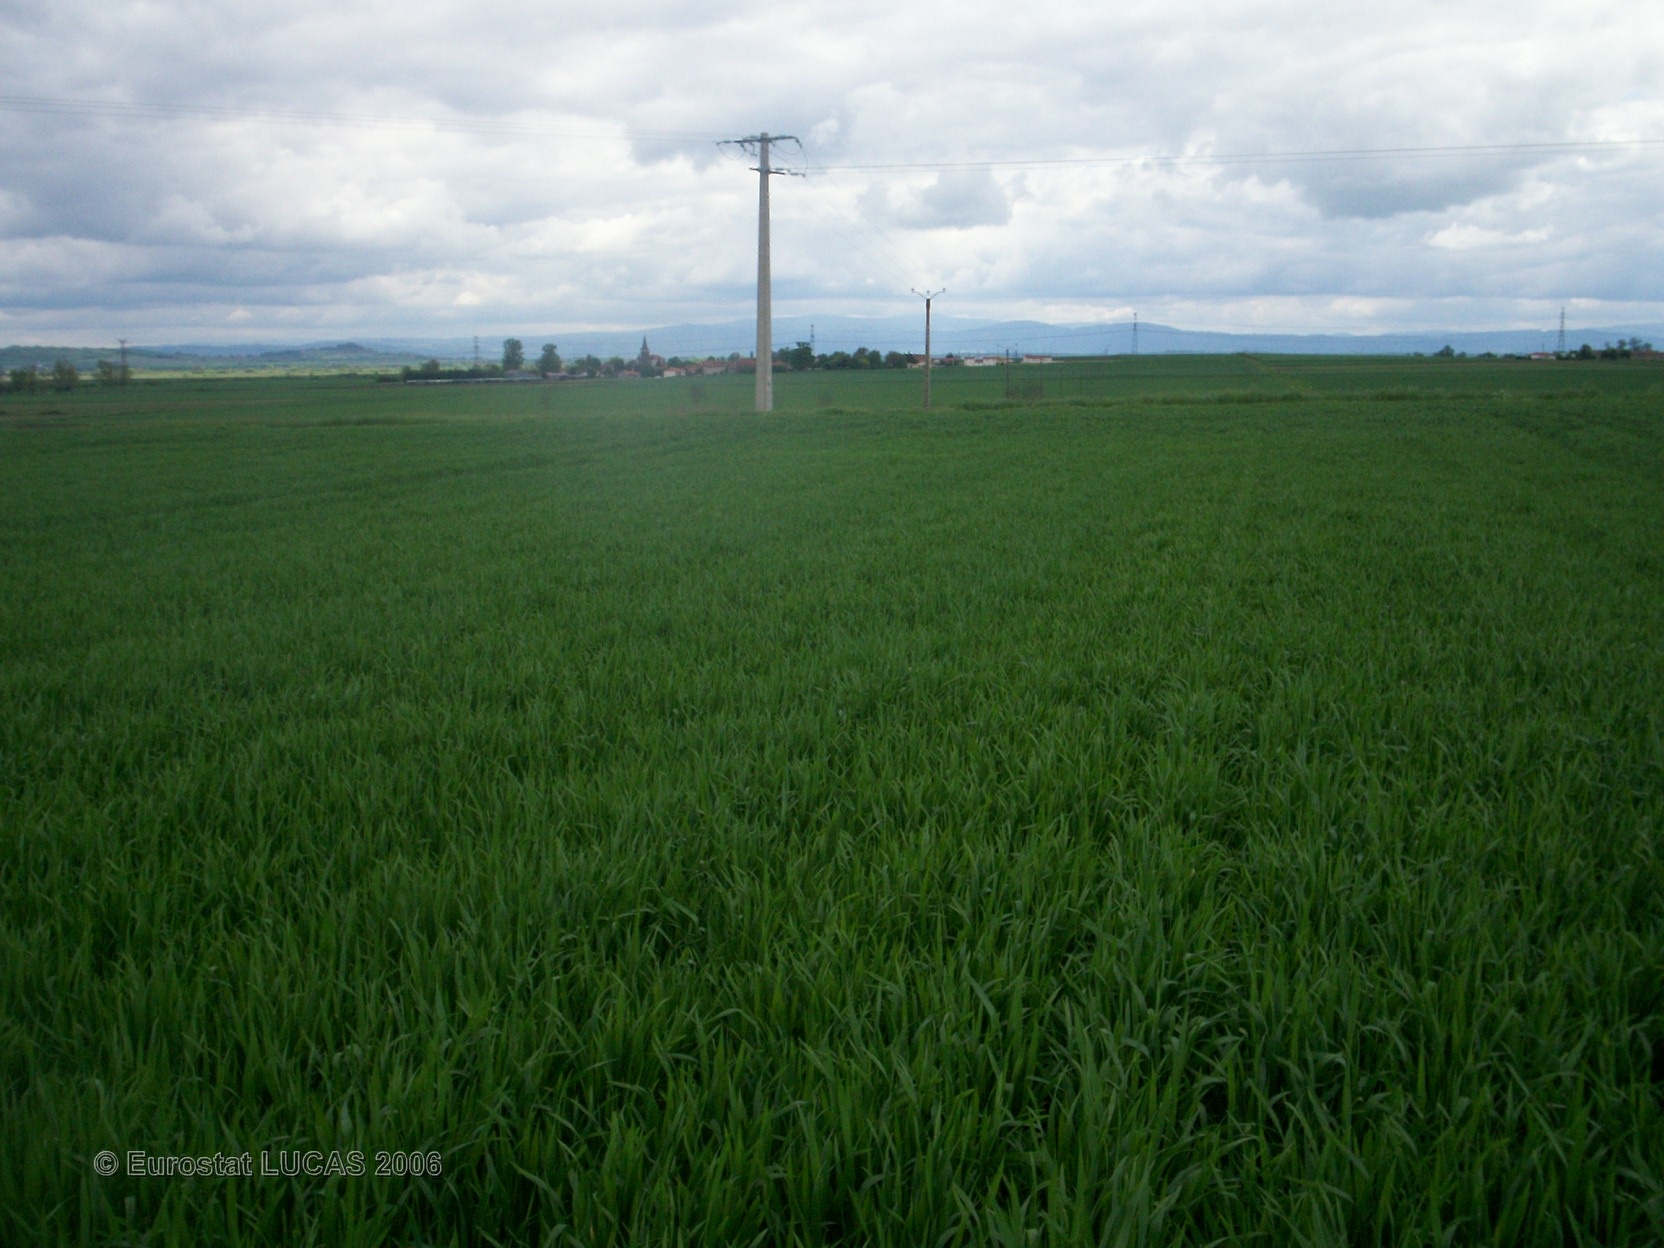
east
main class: Cropland
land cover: Common wheat
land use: Agriculture (excluding fallow land and kitchen gardens)
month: May
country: FR
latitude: 45.9214
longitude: 3.2561
